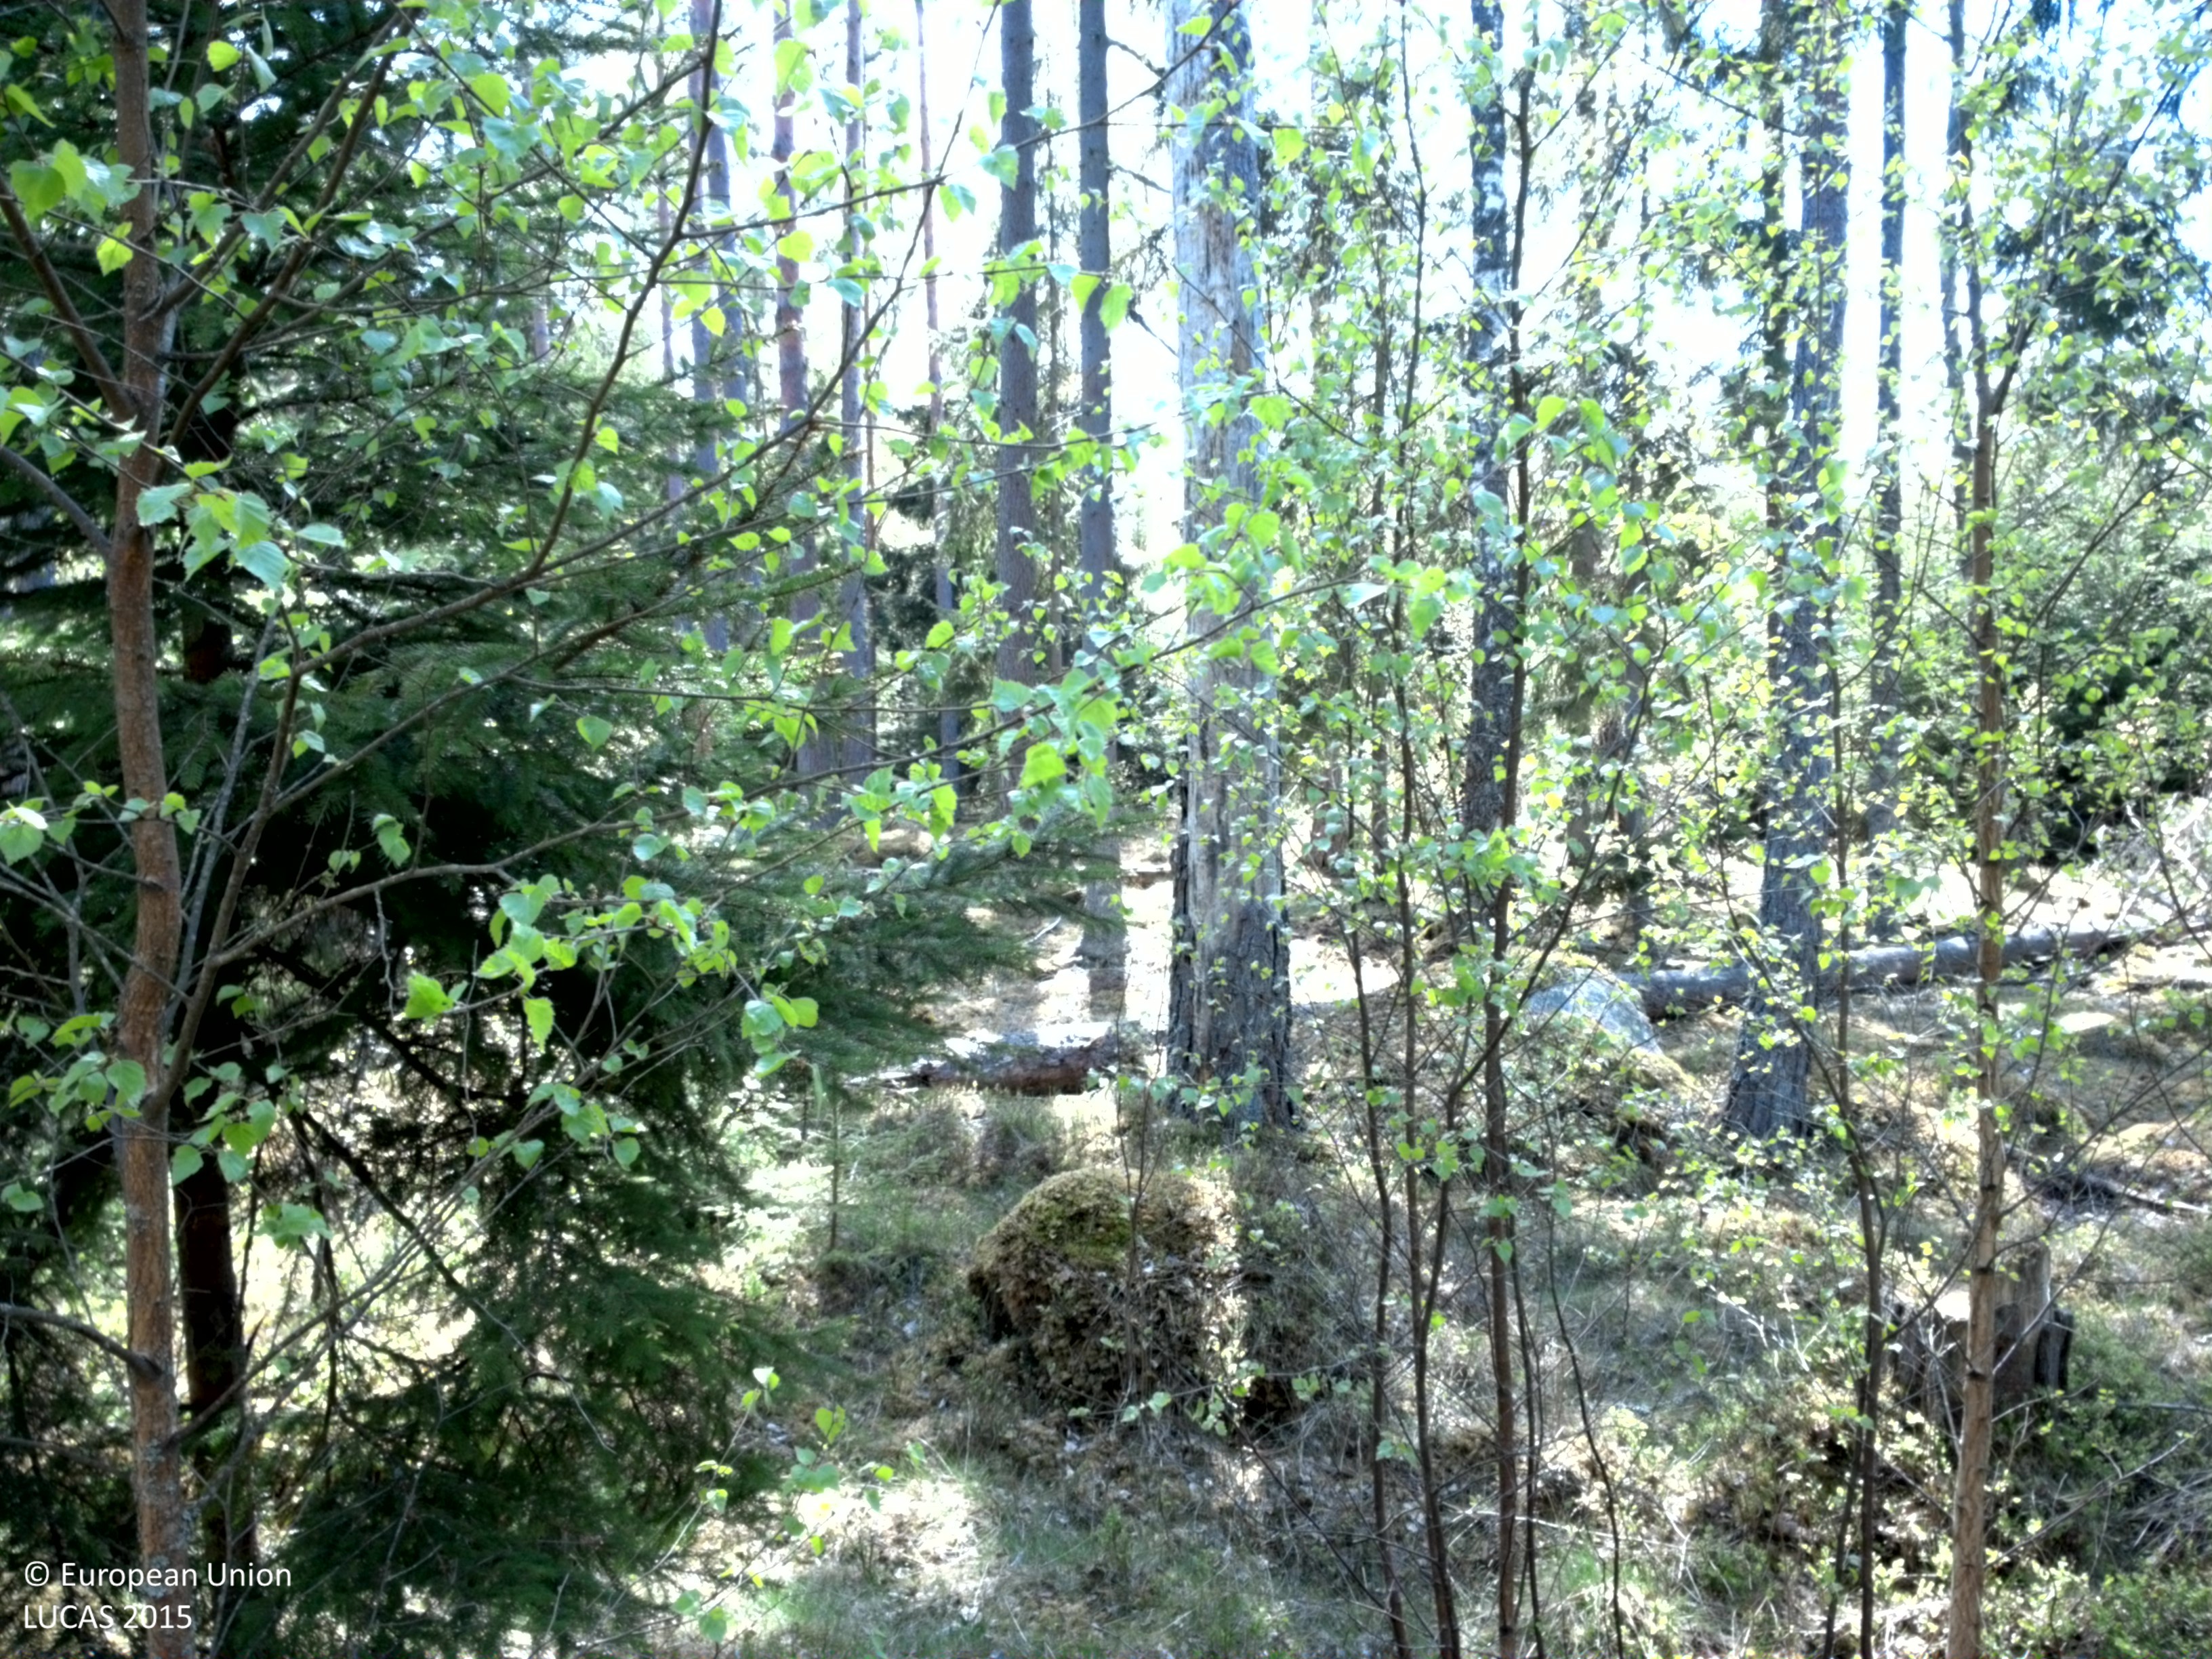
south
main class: Woodland
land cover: Spruce dominated mixed woodland
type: boreal forest
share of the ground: 50 - 75 %
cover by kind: broadleaved forest trees 45 %, coniferous forest trees 25 %, herbaceous plants 15 %, lichens and mosses 15 %
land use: Forestry
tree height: > 5 m
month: May
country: SE
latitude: 56.6728
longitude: 14.8445
